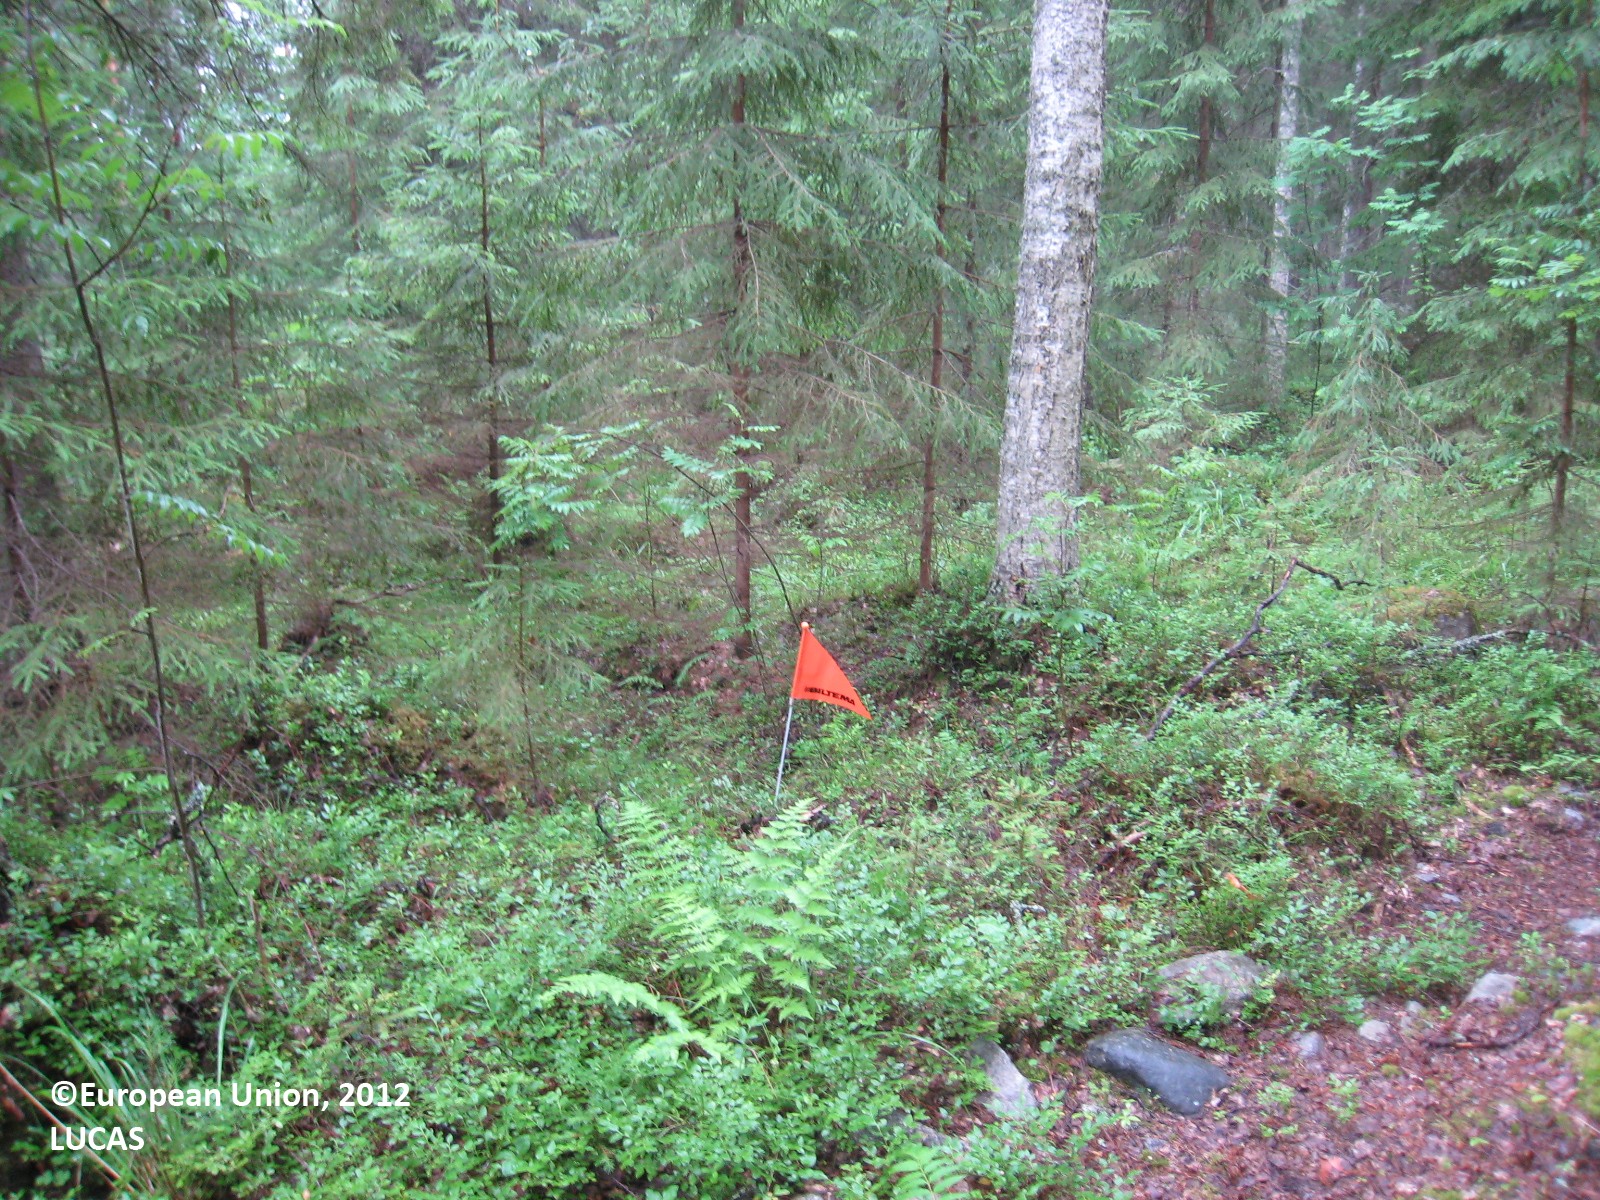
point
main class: Woodland
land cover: Spruce dominated mixed woodland
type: boreal forest
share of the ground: 50 - 75 %
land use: Forestry
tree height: > 5 m
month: July
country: FI
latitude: 61.7807
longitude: 27.0131
